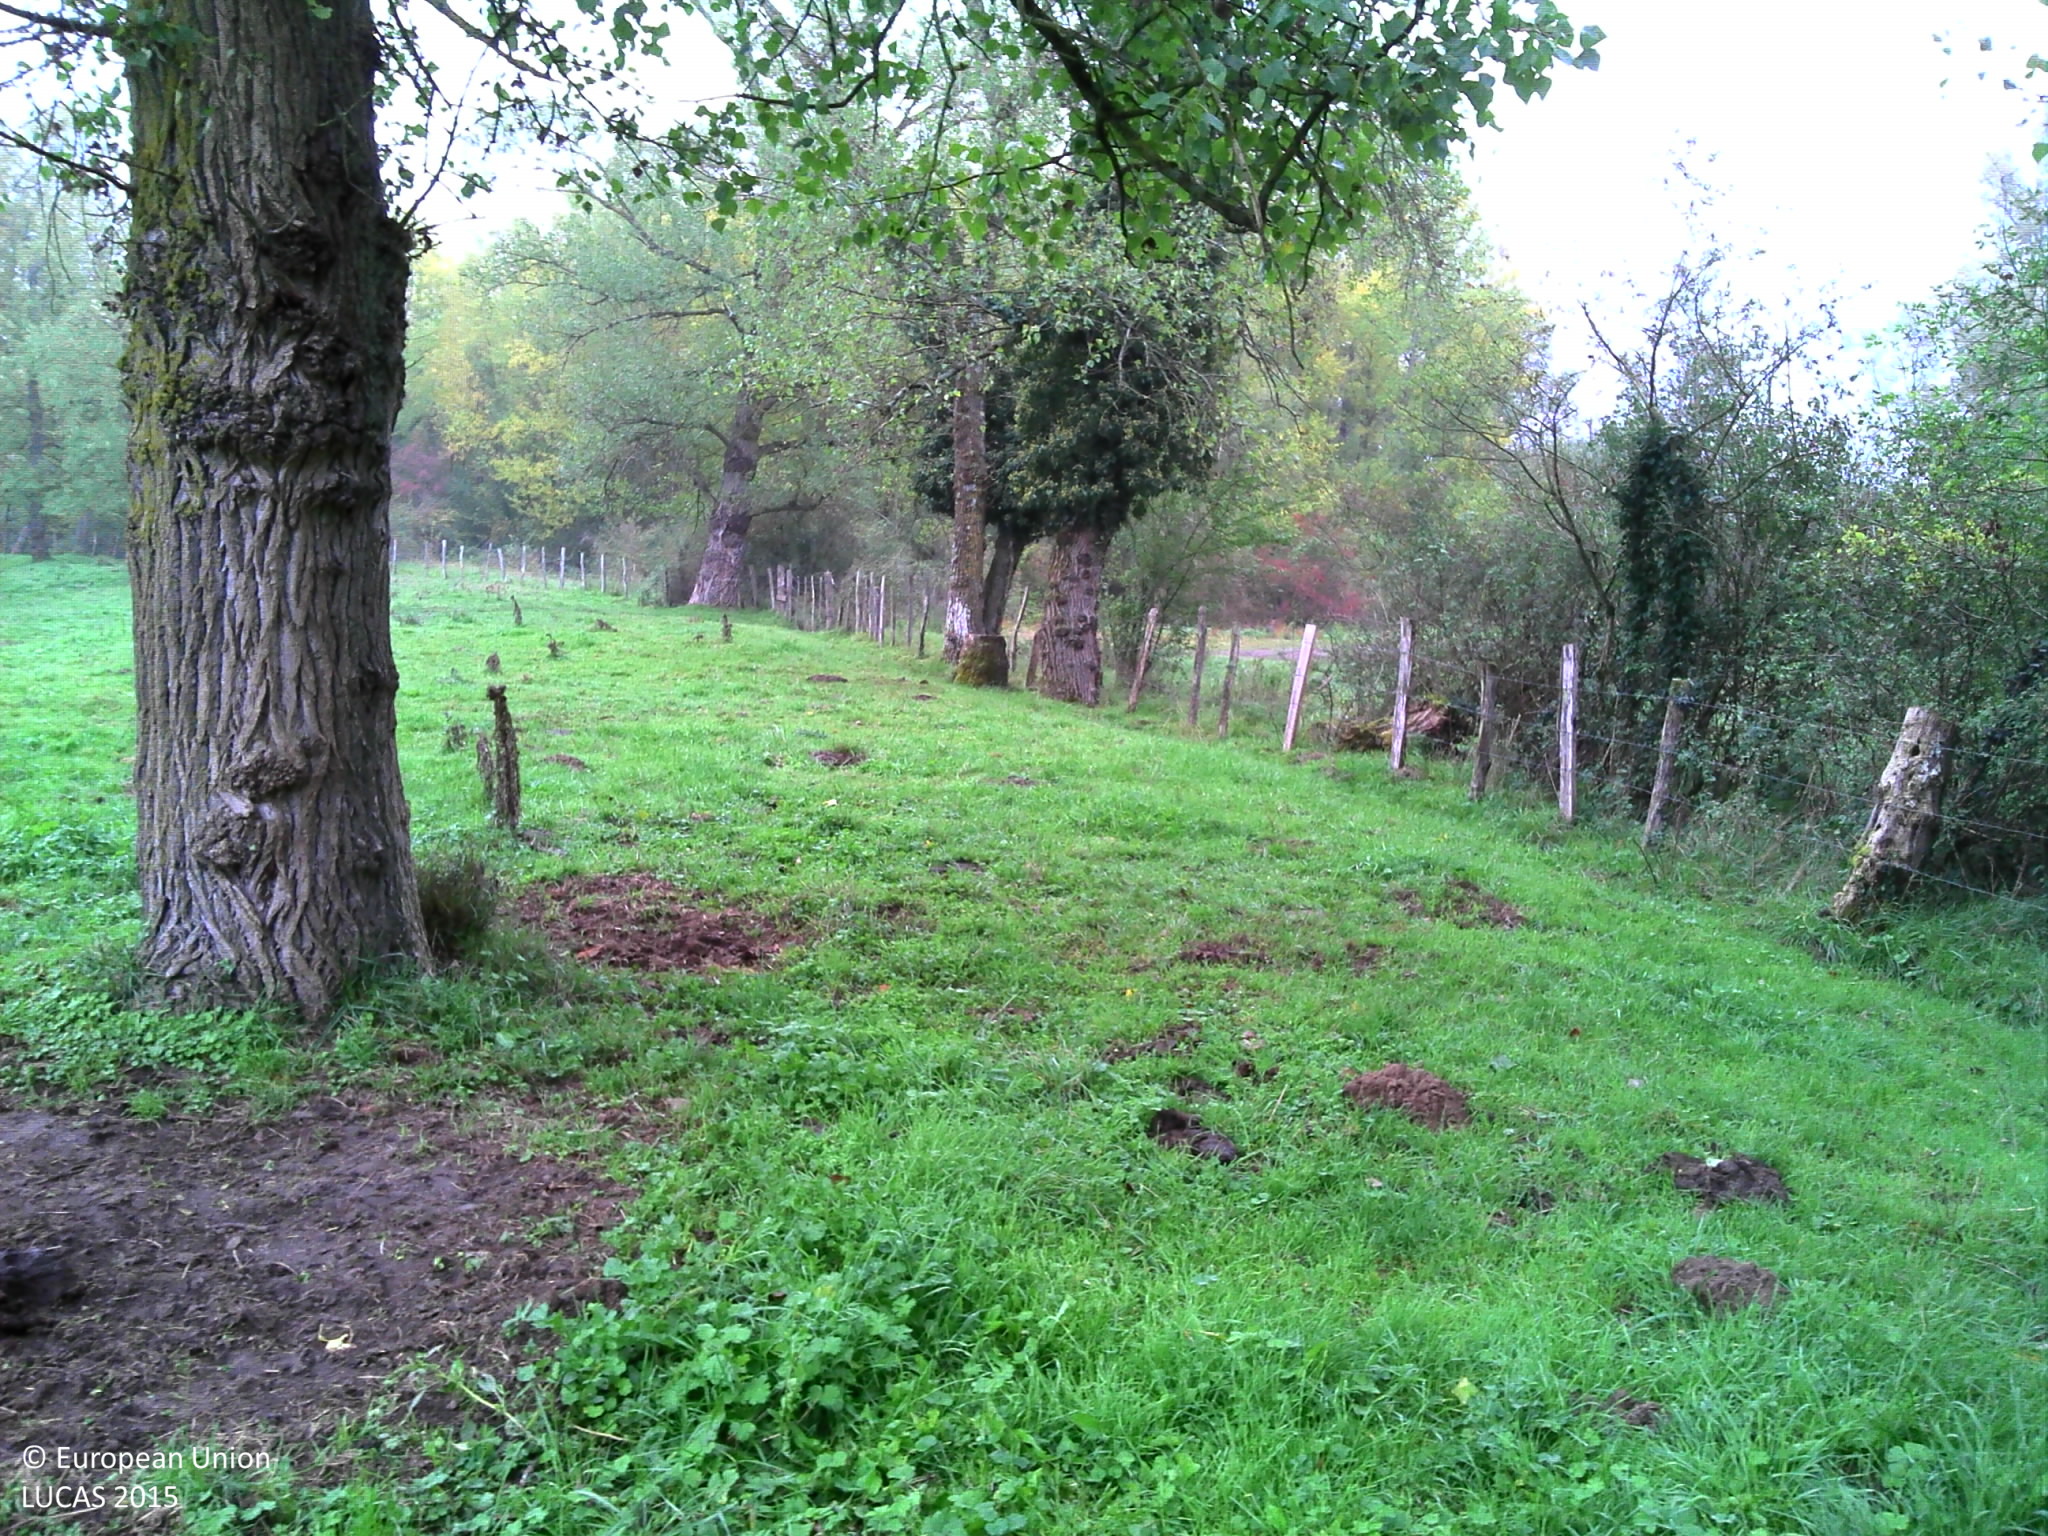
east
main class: Grassland
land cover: Grassland with sparse tree/shrub cover
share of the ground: > 75 %
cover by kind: herbaceous plants 95 %, broadleaved forest trees 5 %
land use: Agriculture (excluding fallow land and kitchen gardens)
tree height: > 5 m
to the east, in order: Grassland with sparse tree/shrub cover; Abandoned hedges; Fences; Tracks; Shrubland without tree cover; Broadleaved woodland; Tracks; Broadleaved woodland; Grassland without tree/shrub cover; Inland marshes; Shrubland without tree cover; Shrubland with sparse tree cover; Fences; Shrubland without tree cover; Tracks; Grassland without tree/shrub cover; Ditches and canals; Managed hedges; Grass margins; Maize
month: October
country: FR
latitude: 45.9295
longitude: 3.3845
